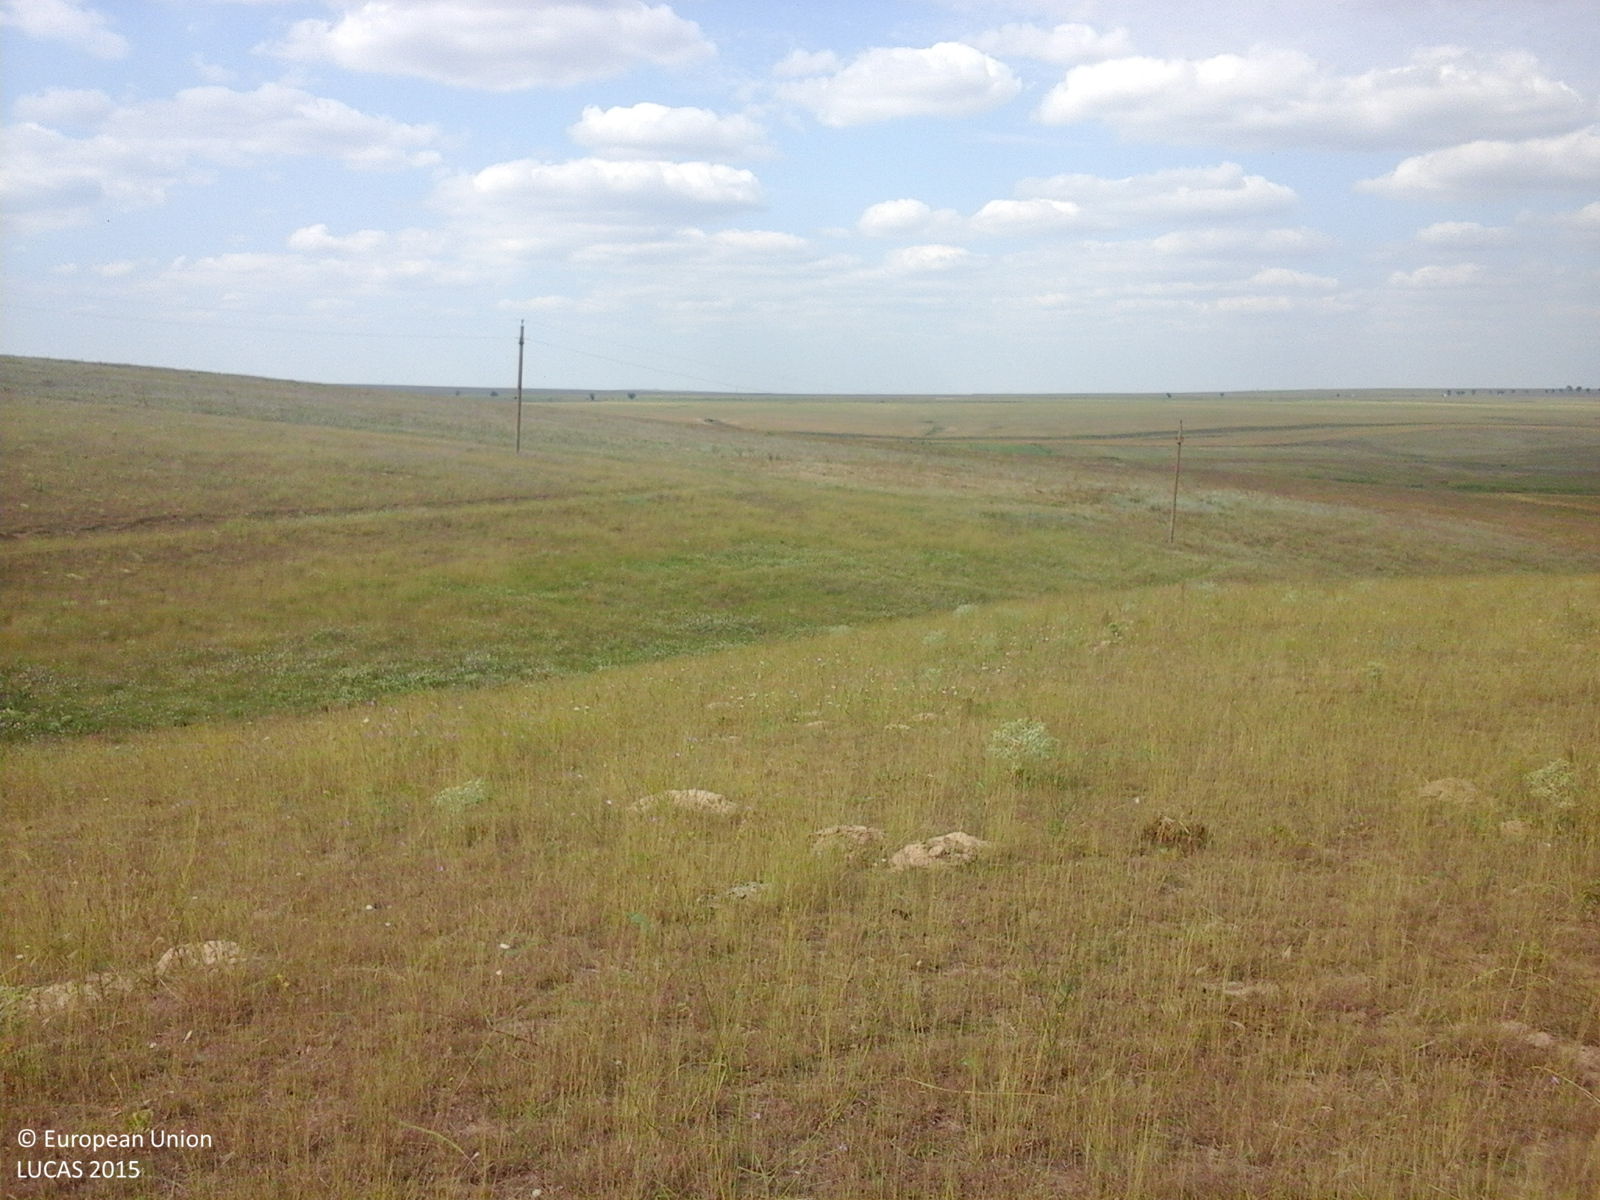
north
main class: Grassland
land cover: Grassland without tree/shrub cover
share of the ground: > 75 %
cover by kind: herbaceous plants 100 %
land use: Agriculture (excluding fallow land and kitchen gardens)
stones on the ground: < 10 %
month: August
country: RO
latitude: 44.7205
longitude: 28.1815
